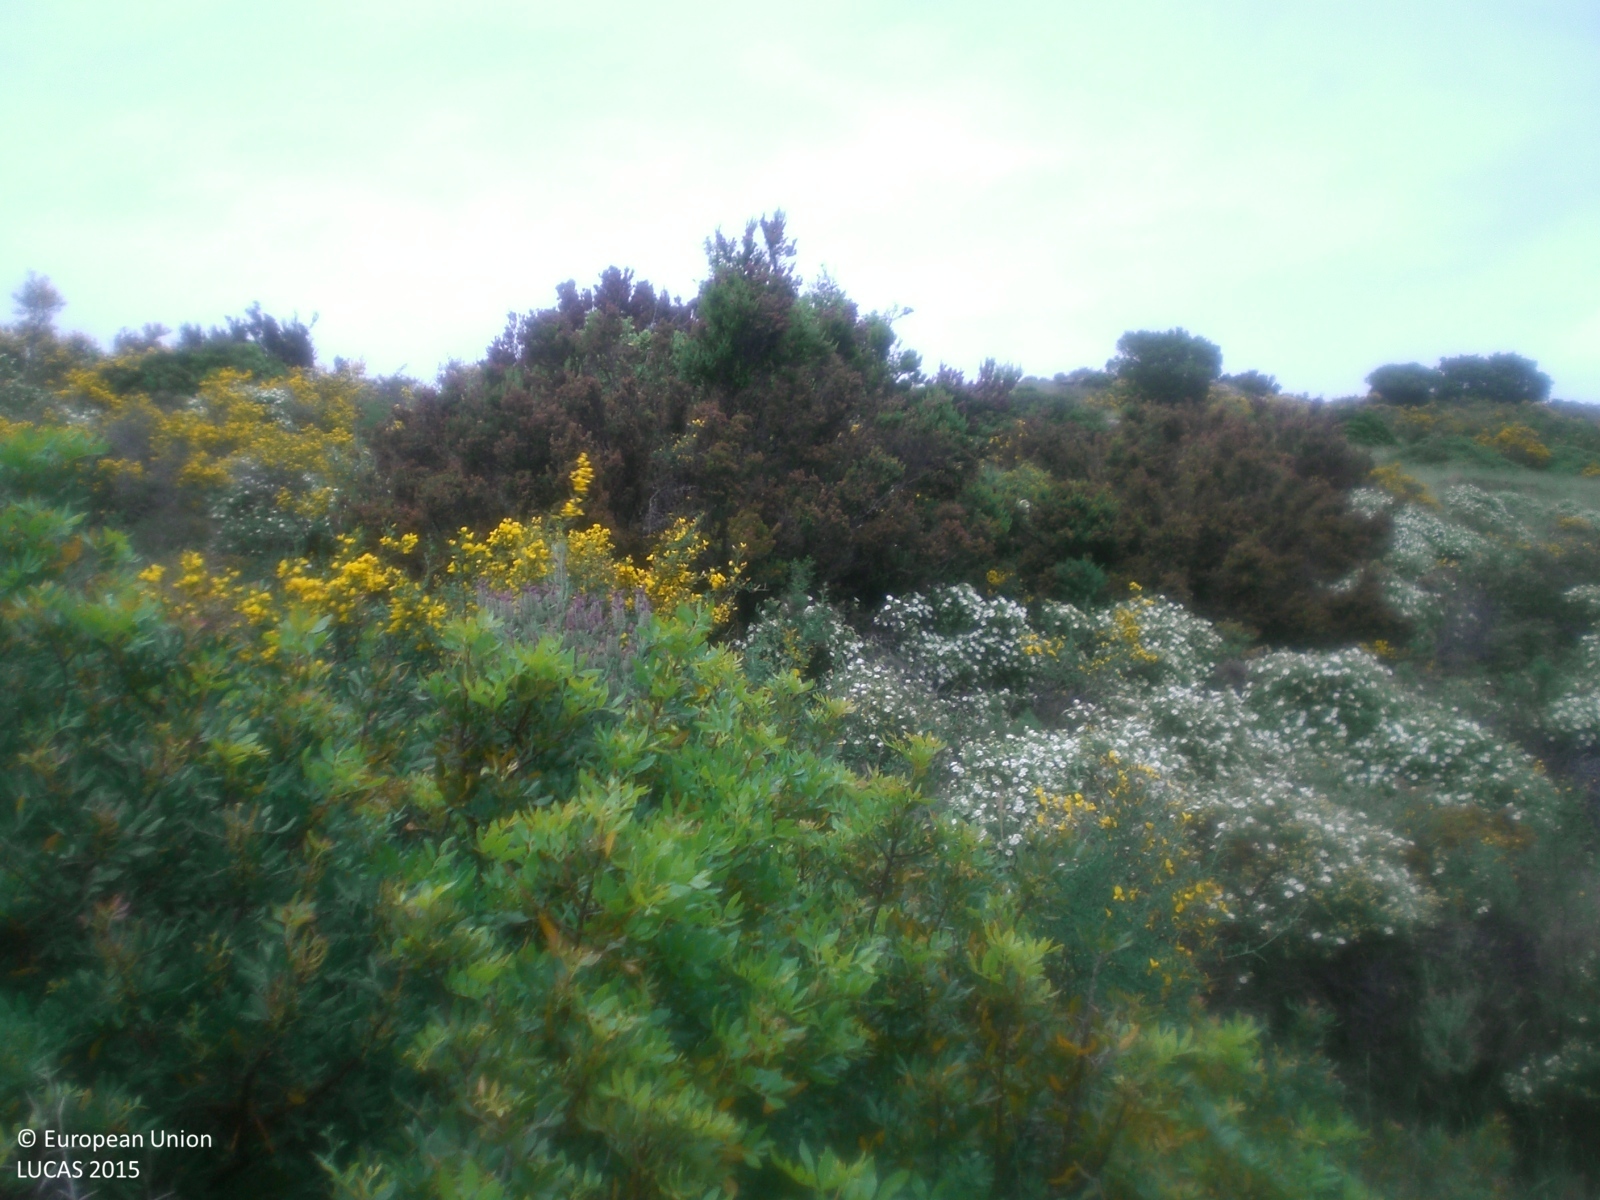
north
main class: Shrubland
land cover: Shrubland with sparse tree cover
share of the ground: > 75 %
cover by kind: shrubs 95 %, broadleaved forest trees 5 %
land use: Semi-natural and natural areas not in use
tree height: < 5 m
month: May
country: ES
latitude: 42.2632
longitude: 3.2136
